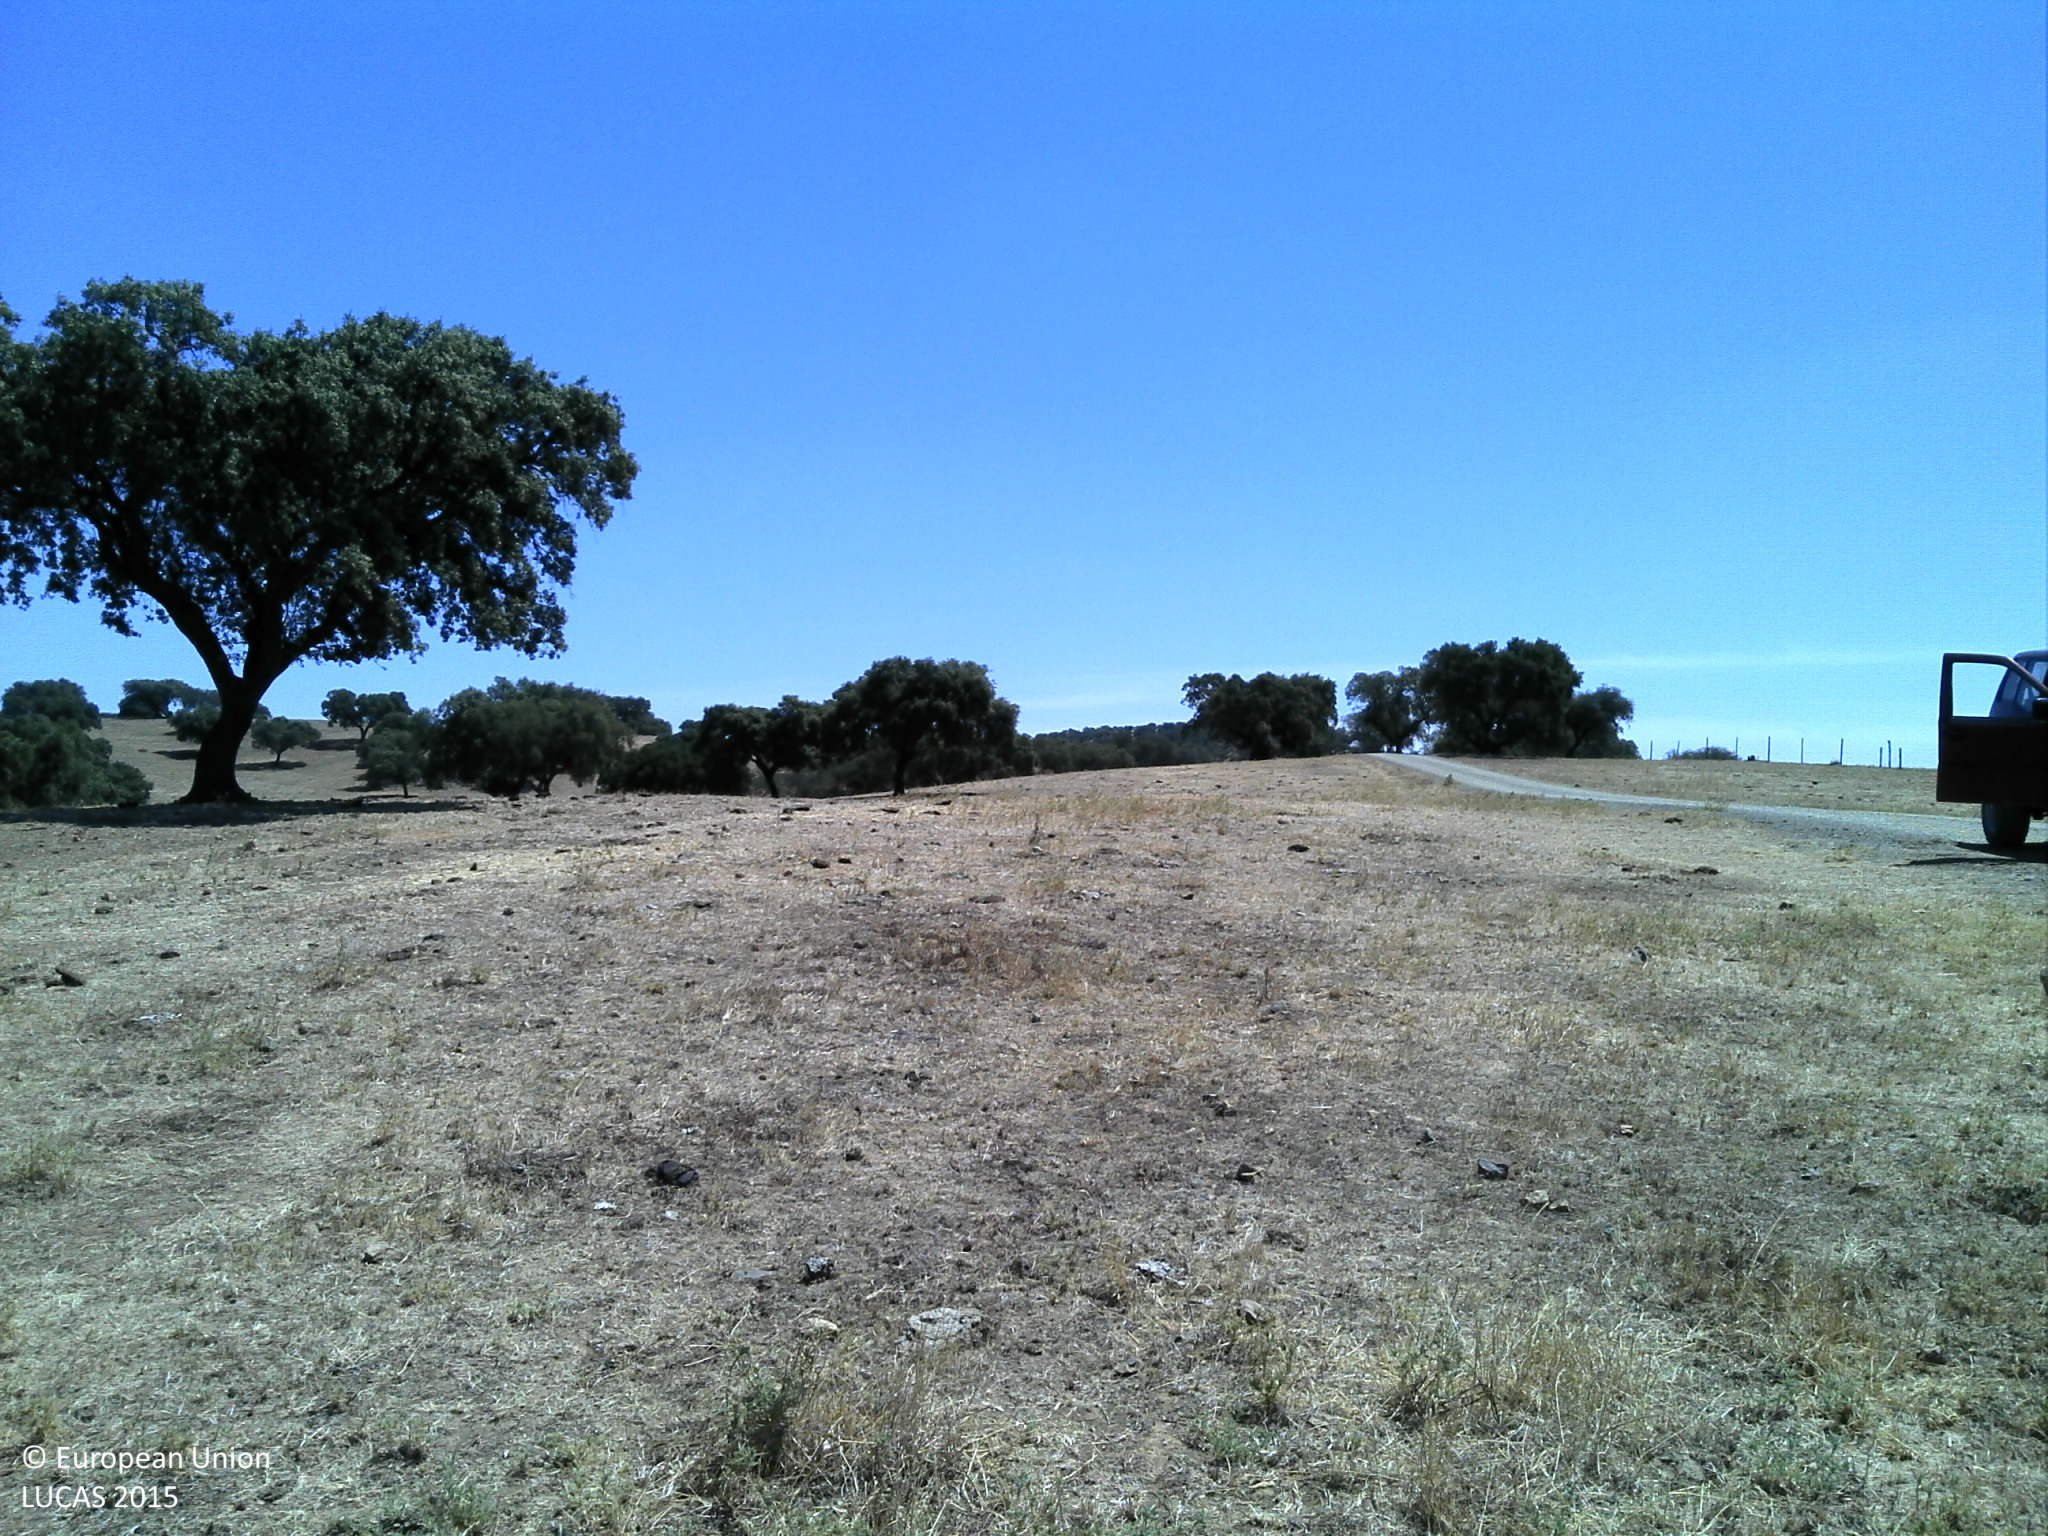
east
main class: Grassland
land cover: Grassland without tree/shrub cover
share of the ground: < 10 %
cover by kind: unconsolidated bare surface 90 %, herbaceous plants 10 %
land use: Agriculture (excluding fallow land and kitchen gardens)
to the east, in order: Grassland without tree/shrub cover; Tracks; Grassland without tree/shrub cover; Fences; Grassland without tree/shrub cover; Fences; Grass margins; Tracks; Grassland without tree/shrub cover; Broadleaved woodland
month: June
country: PT
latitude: 38.2659
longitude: -8.1318
